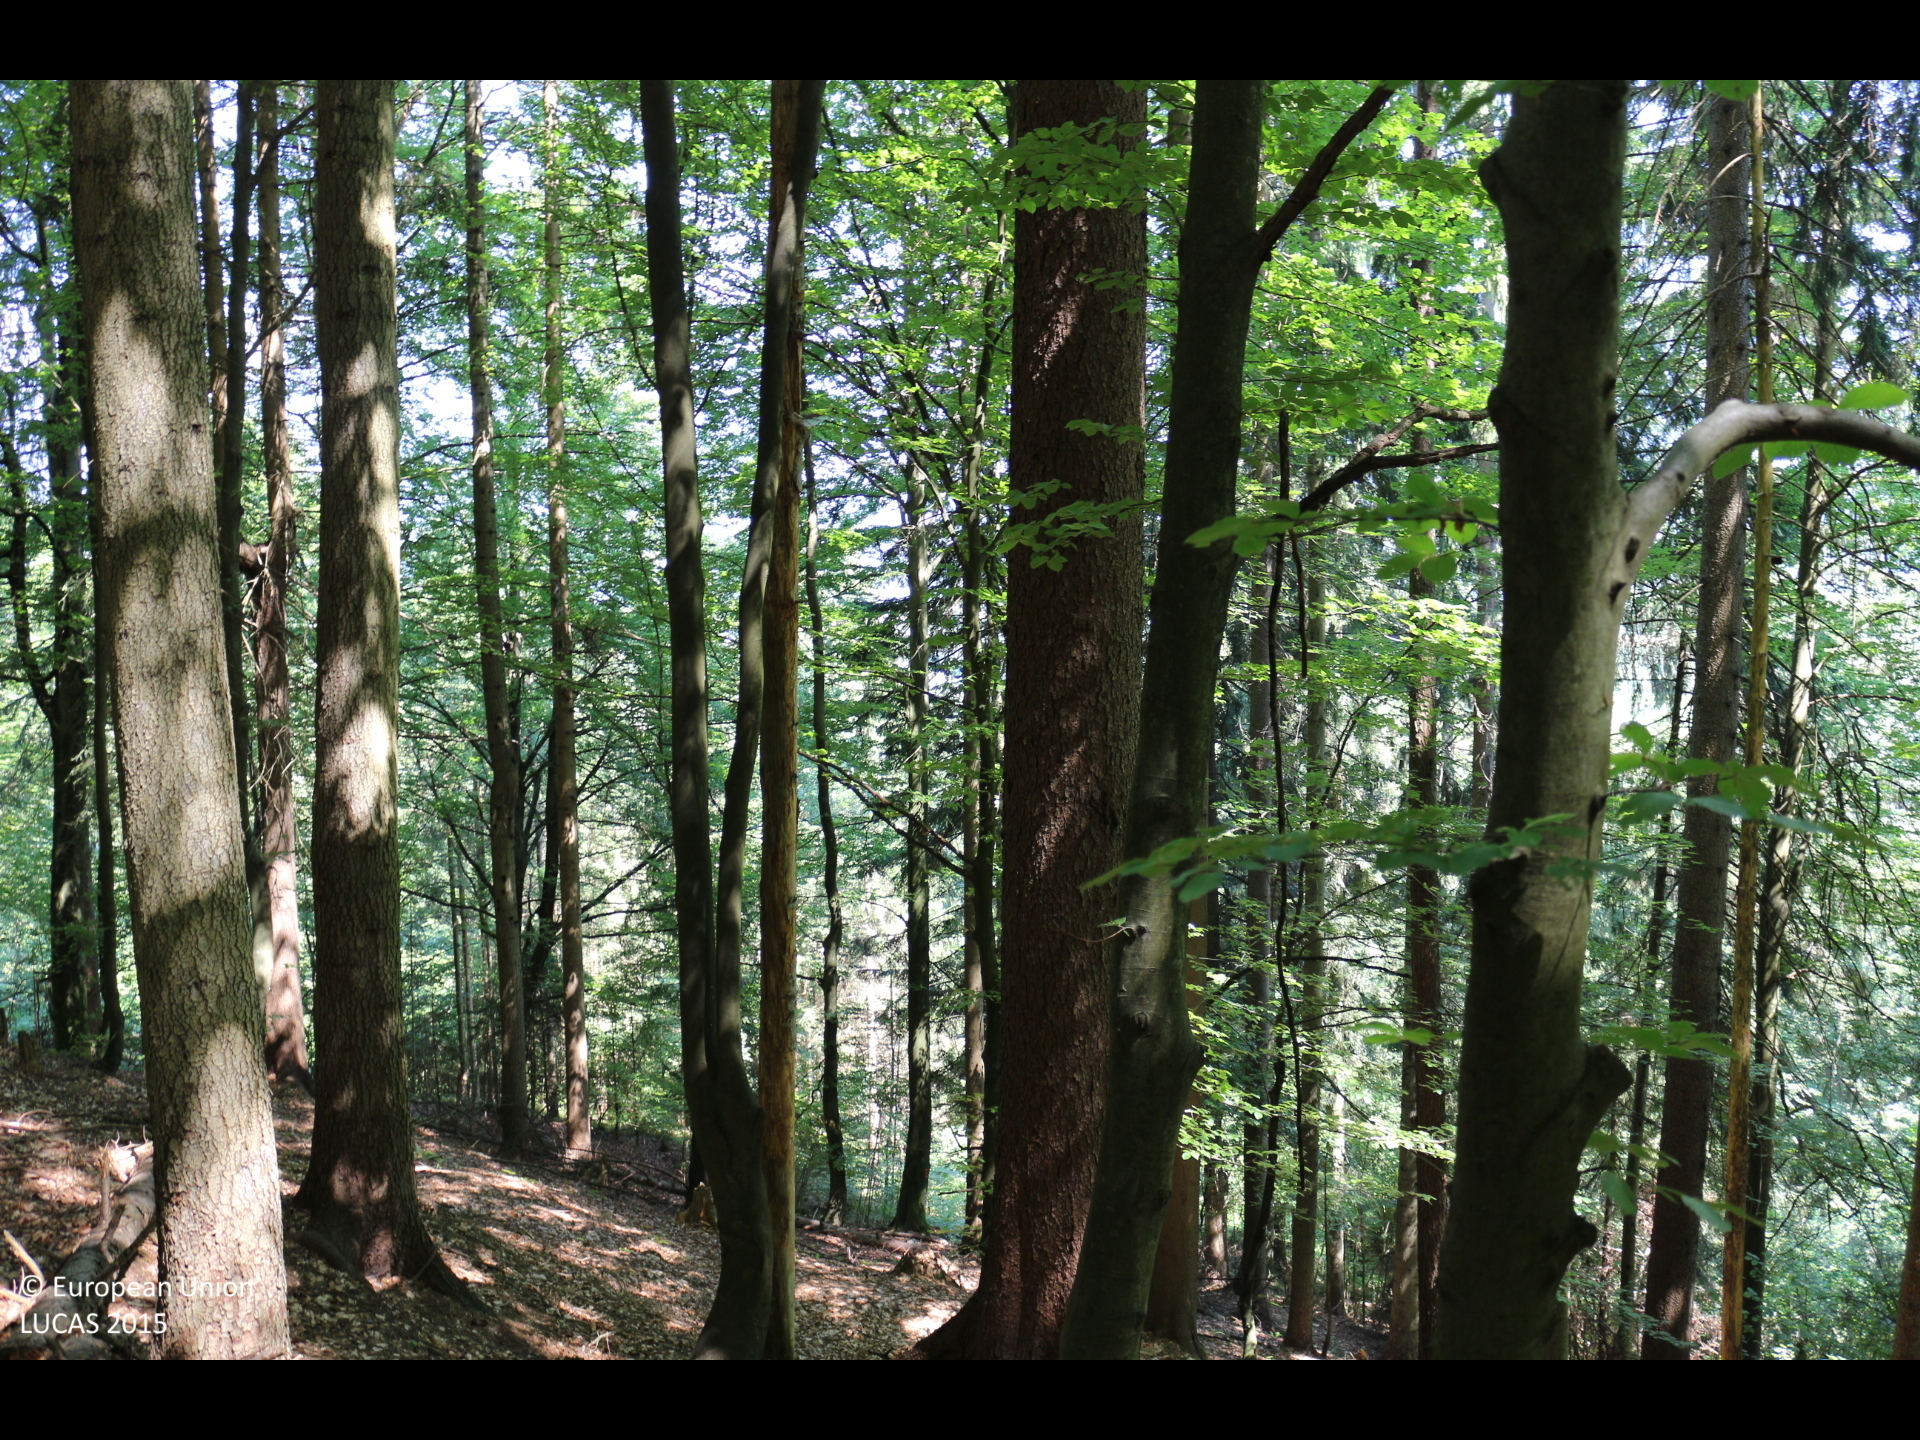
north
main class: Woodland
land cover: Other mixed woodland
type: mountainous beech forest
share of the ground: > 75 %
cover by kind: broadleaved forest trees 60 %, coniferous forest trees 40 %
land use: Forestry
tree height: > 5 m
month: July
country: AT
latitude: 46.5804
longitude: 13.5596
